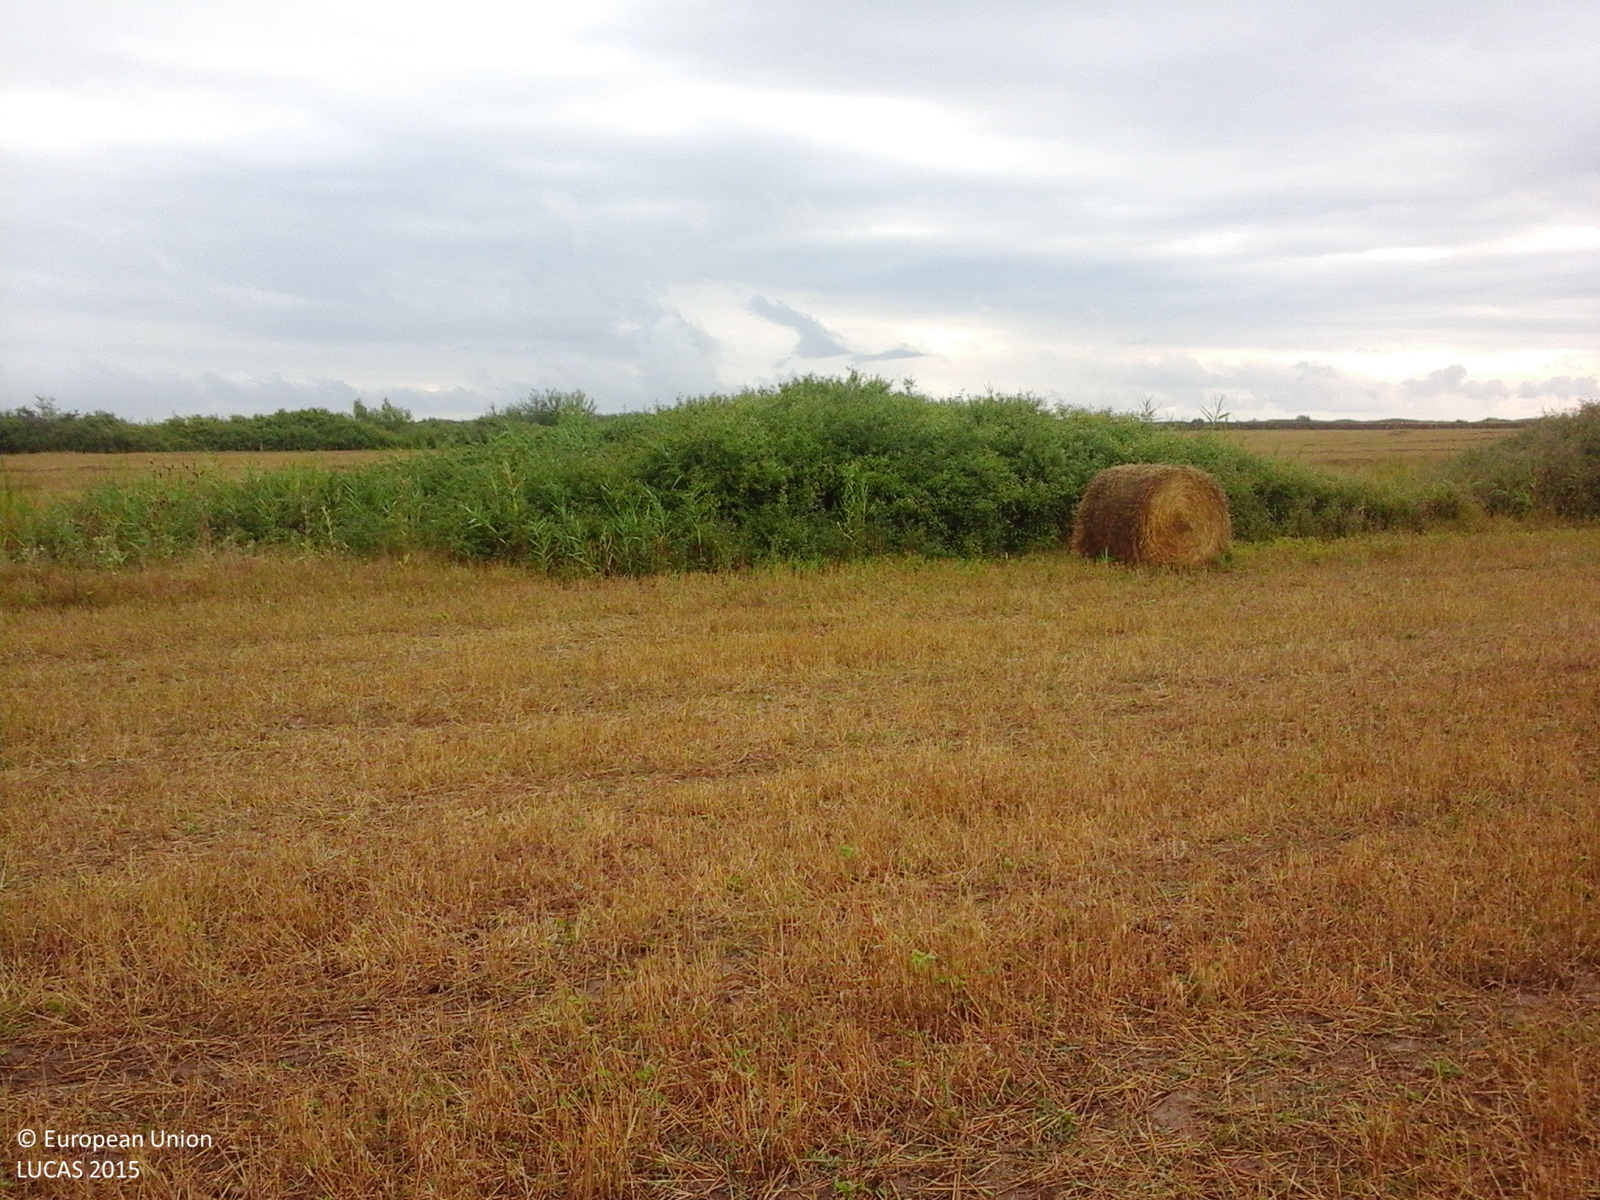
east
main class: Cropland
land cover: Common wheat
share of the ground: 50 - 75 %
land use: Agriculture (excluding fallow land and kitchen gardens)
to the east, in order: Common wheat; Abandoned hedges; Ditches and canals; Abandoned hedges; Common wheat; Shruby margins; Ditches and canals; Shruby margins; Common wheat
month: August
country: RO
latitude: 45.5731
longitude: 21.0866
